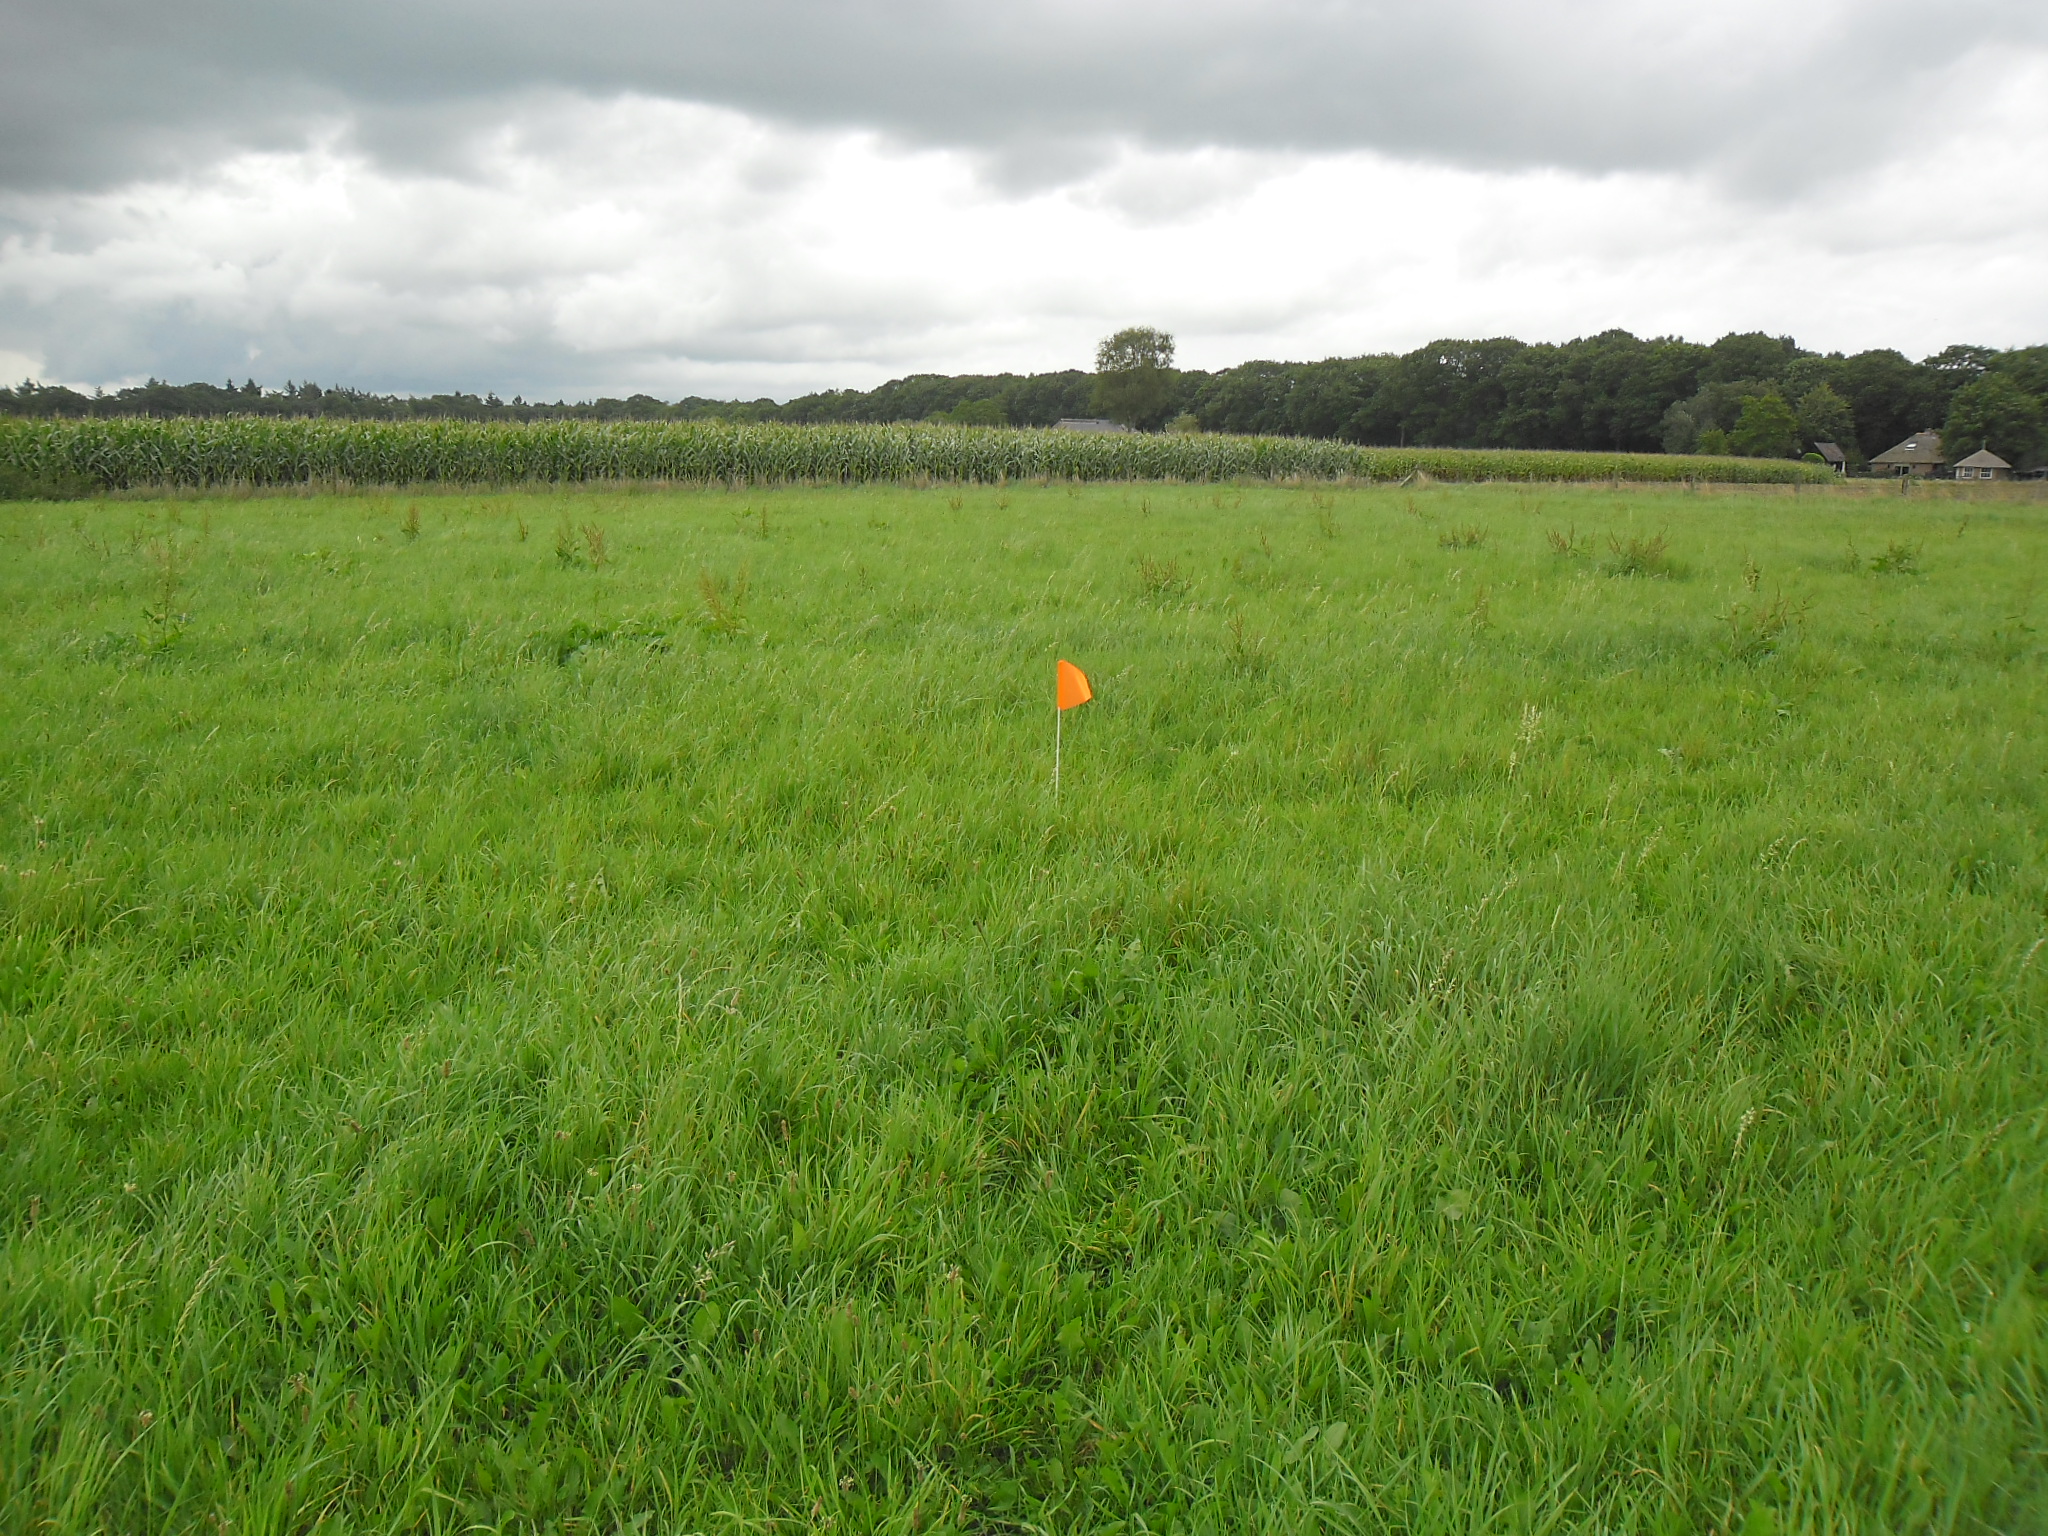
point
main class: Grassland
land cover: Grassland without tree/shrub cover
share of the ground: > 75 %
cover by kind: herbaceous plants 100 %
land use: Agriculture (excluding fallow land and kitchen gardens)
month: September
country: NL
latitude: 52.2090
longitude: 6.2091
